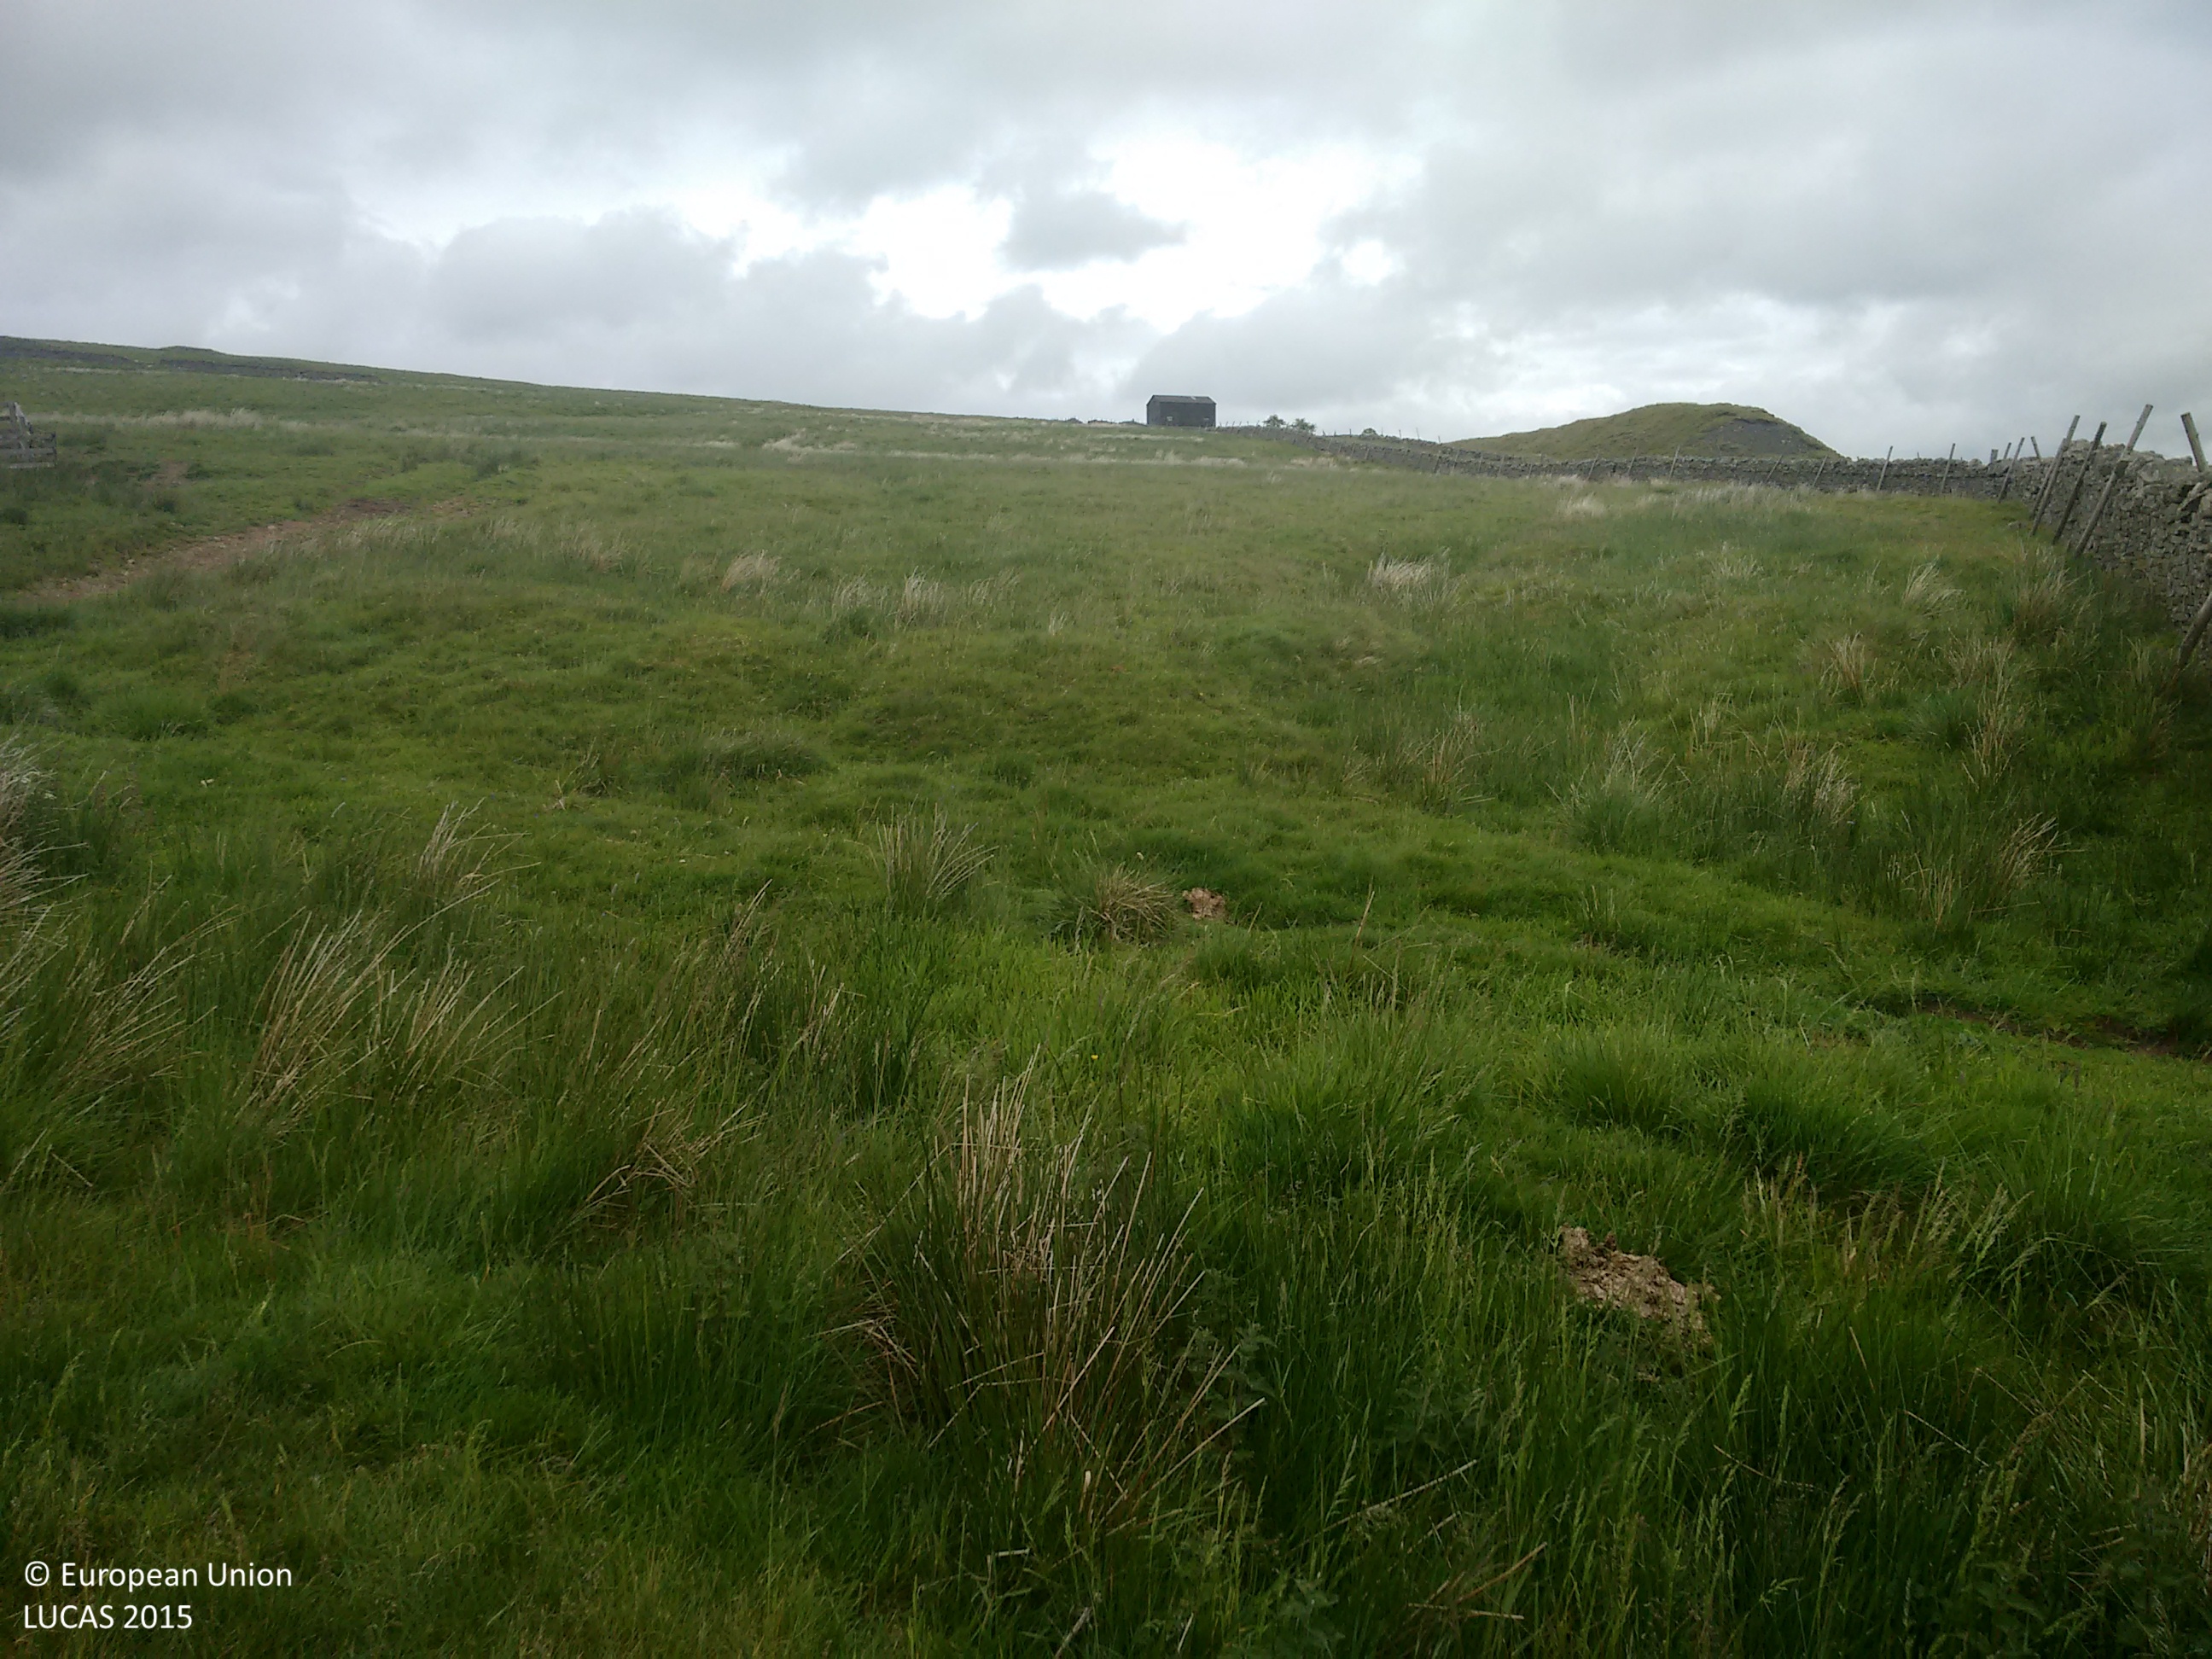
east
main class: Grassland
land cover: Grassland without tree/shrub cover
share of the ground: > 75 %
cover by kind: herbaceous plants 100 %
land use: Agriculture (excluding fallow land and kitchen gardens)
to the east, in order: Grassland without tree/shrub cover; Fences; Dry stone walls; Grassland without tree/shrub cover; Paved roads, cycling and walking lanes; Grass margins; Dry stone walls; Grassland without tree/shrub cover; Fences; Dry stone walls; Grassland without tree/shrub cover; Dry stone walls; Fences; Grassland without tree/shrub cover
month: June
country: GB
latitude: 54.7482
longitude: -2.1916
